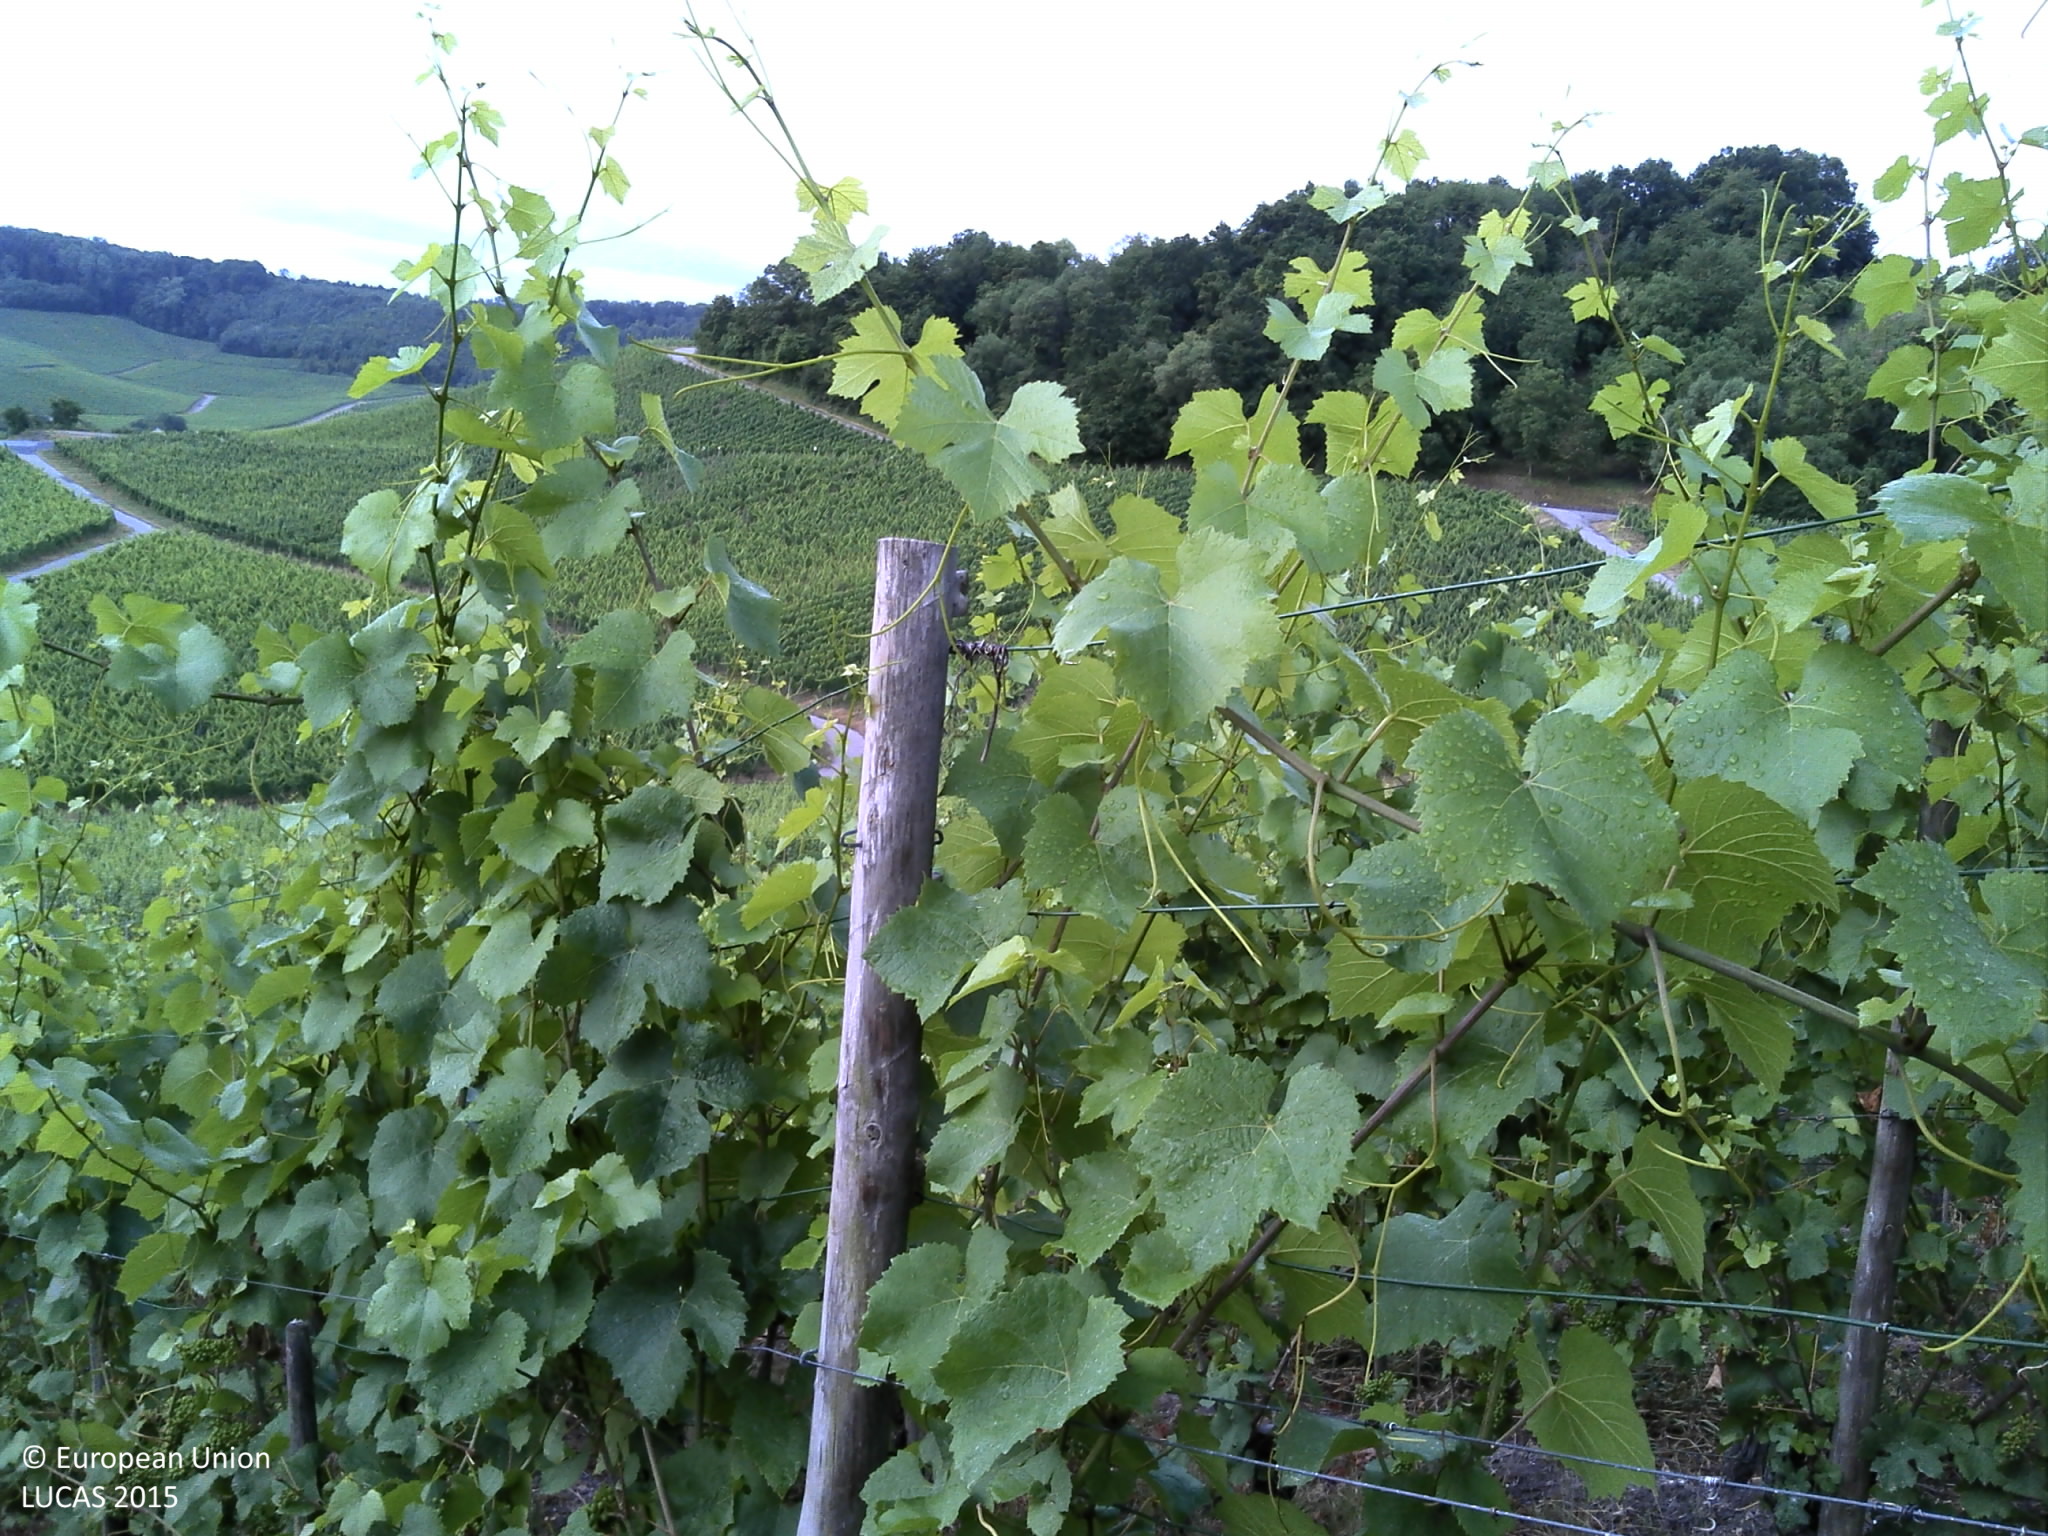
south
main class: Cropland
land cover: Vineyards
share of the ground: 50 - 75 %
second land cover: Grassland without tree/shrub cover
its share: 50 - 75 %
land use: Agriculture (excluding fallow land and kitchen gardens)
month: July
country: LU
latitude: 49.5314
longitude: 6.3382
